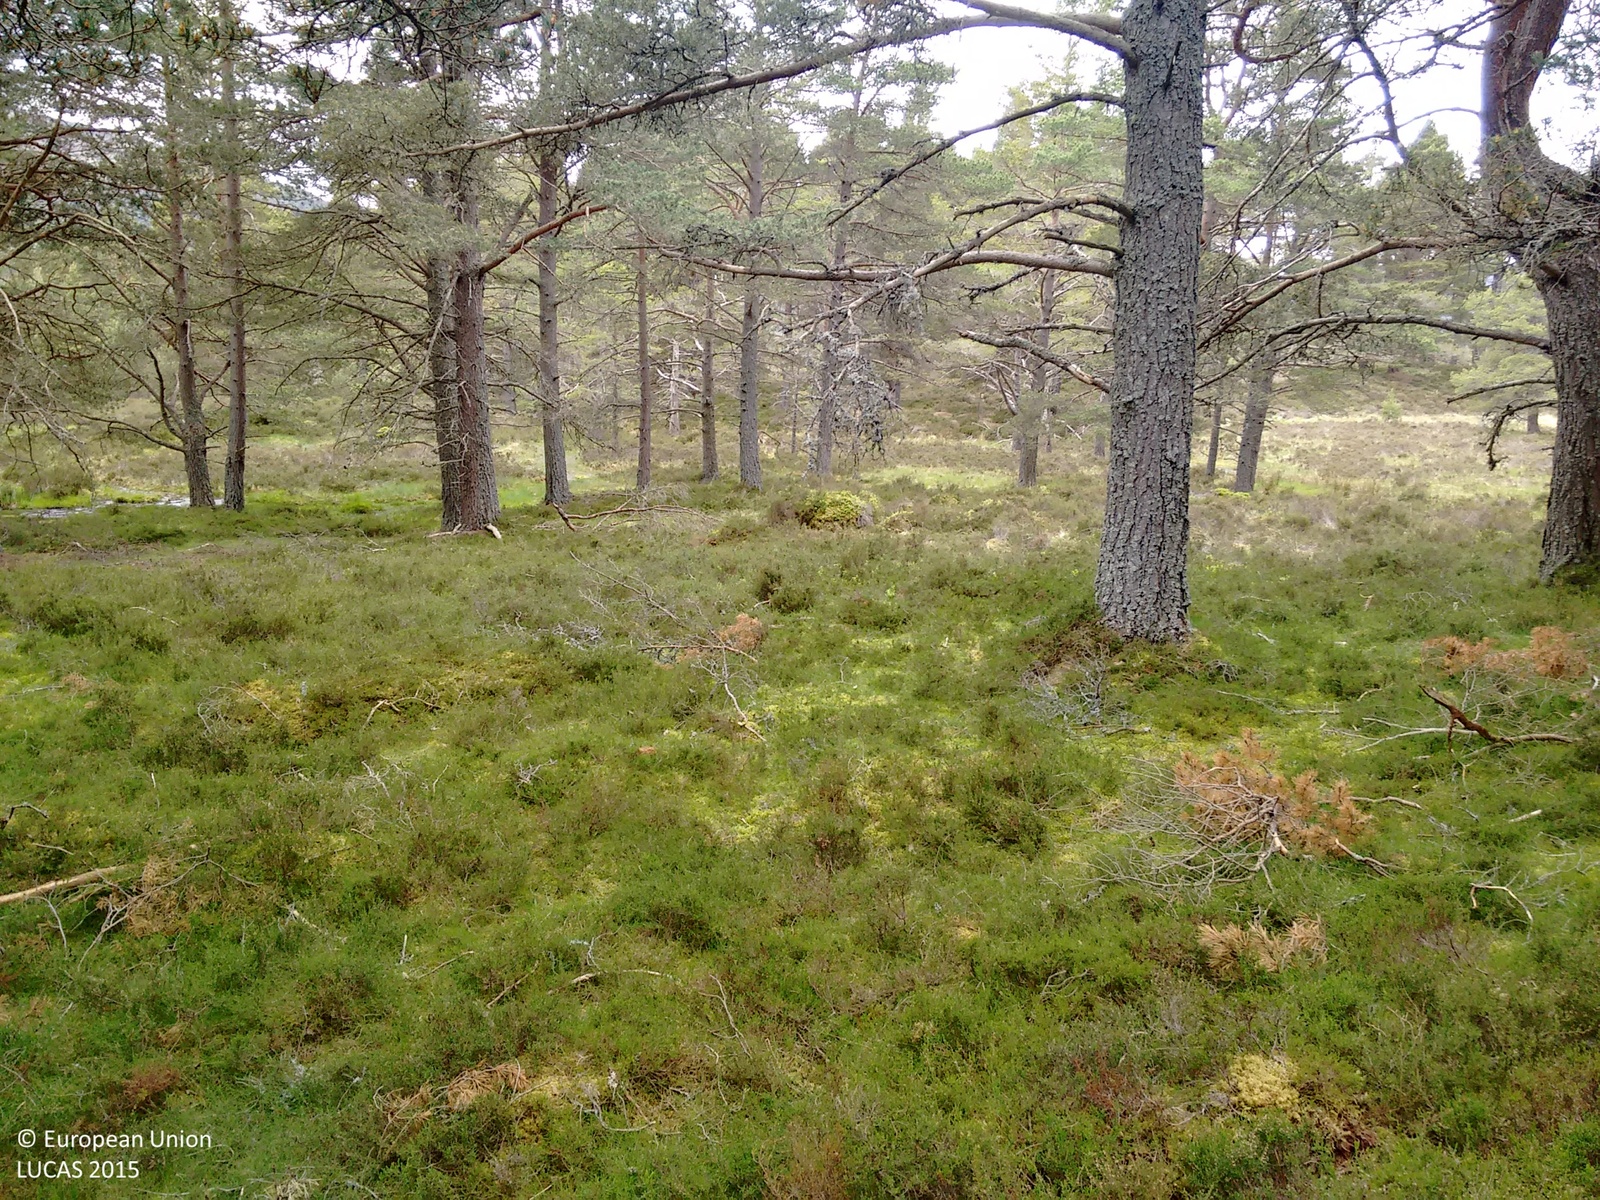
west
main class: Woodland
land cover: Pine dominated coniferous woodland
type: exotic forest
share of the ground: > 75 %
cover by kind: coniferous forest trees 85 %, herbaceous plants 10 %, lichens and mosses 5 %
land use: Semi-natural and natural areas not in use
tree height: > 5 m
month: June
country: GB
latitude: 57.0042
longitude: -3.3234
